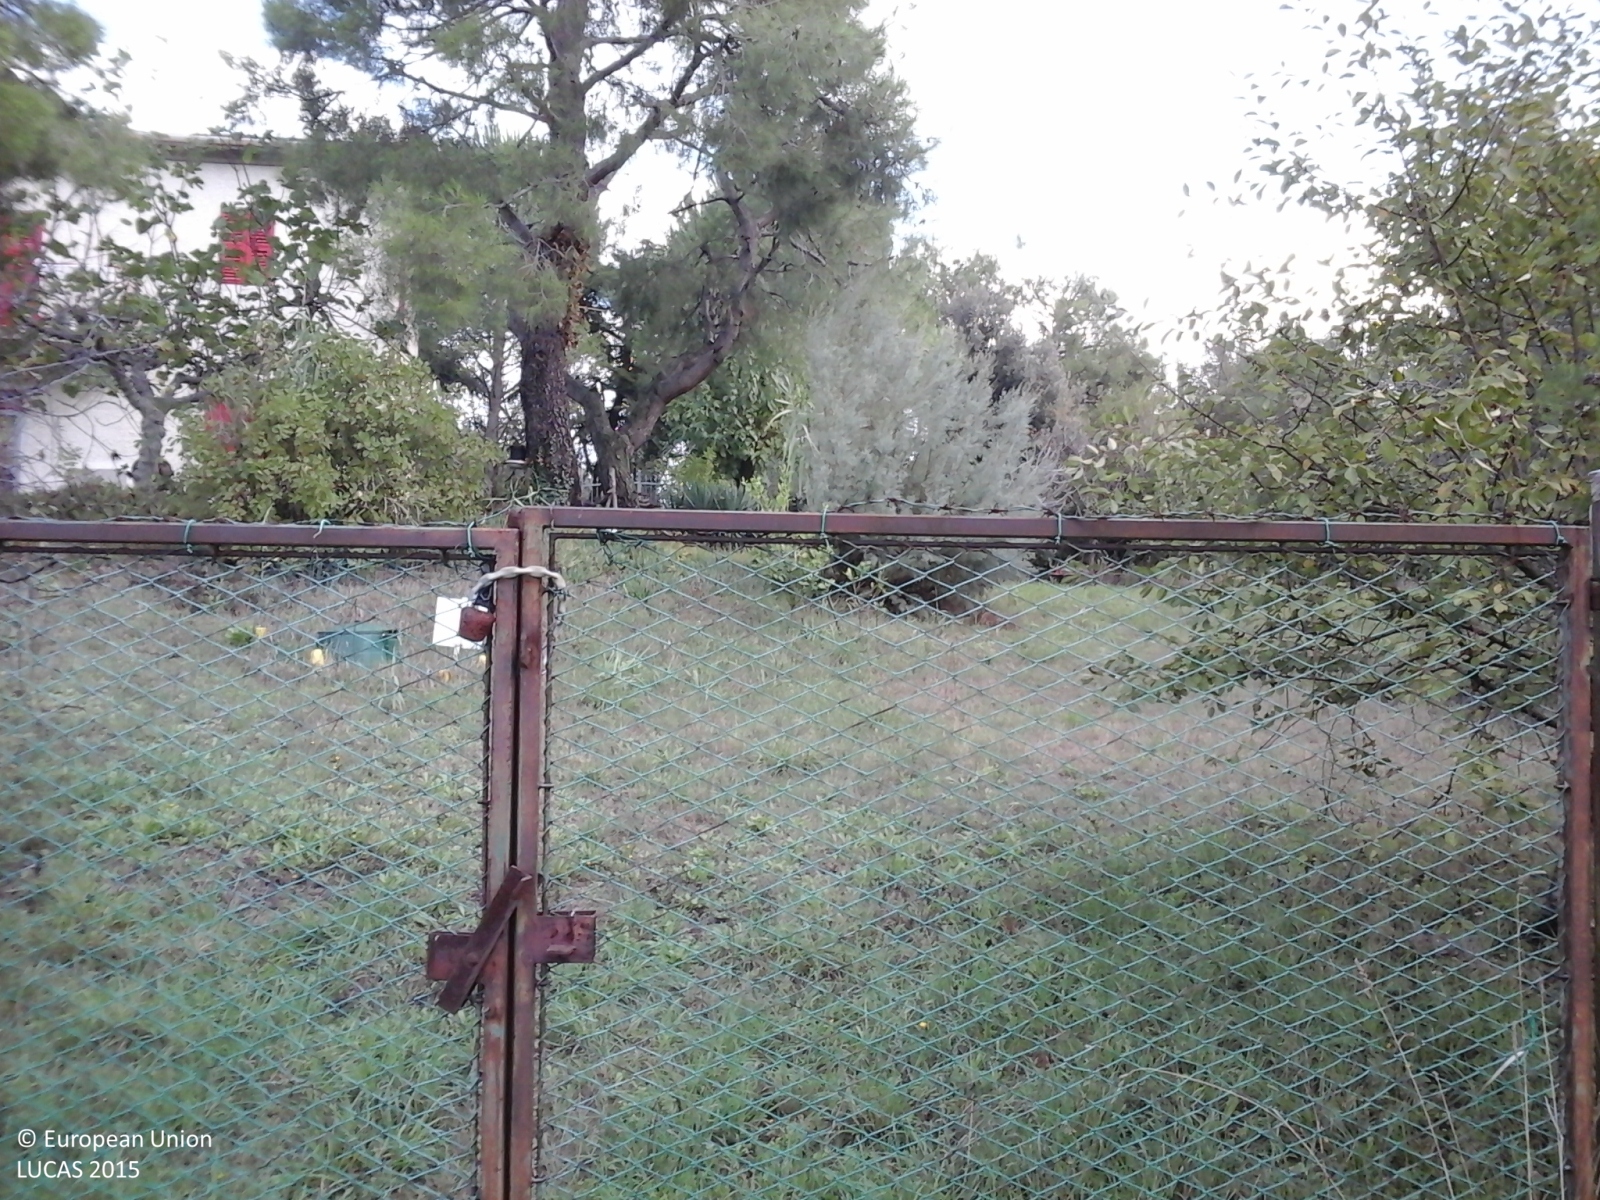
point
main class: Woodland
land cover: Pine dominated mixed woodland
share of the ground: > 75 %
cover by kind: coniferous forest trees 40 %, herbaceous plants 40 %, broadleaved forest trees 20 %
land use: Residential
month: October
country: IT
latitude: 43.5744
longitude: 13.3476
